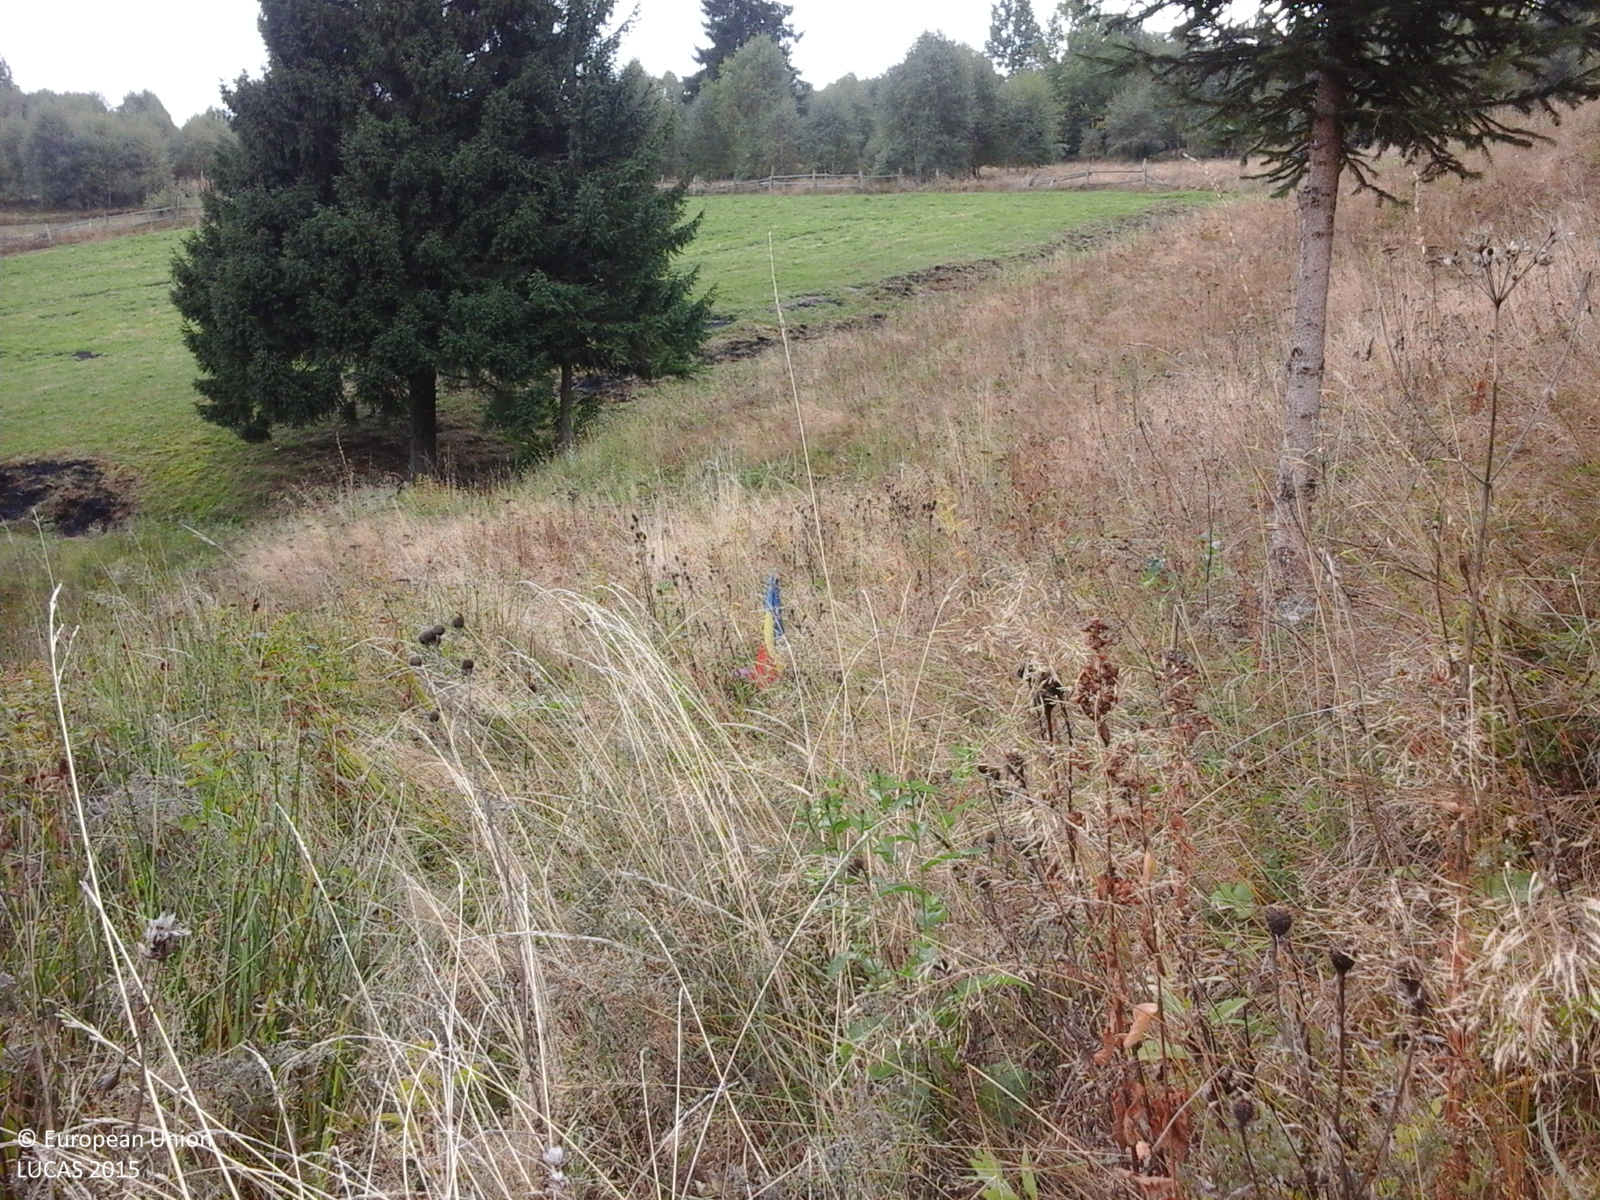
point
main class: Grassland
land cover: Spontaneously vegetated surfaces
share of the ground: > 75 %
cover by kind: herbaceous plants 100 %
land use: Forestry
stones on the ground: < 10 %
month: October
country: RO
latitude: 45.7360
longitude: 23.8586
